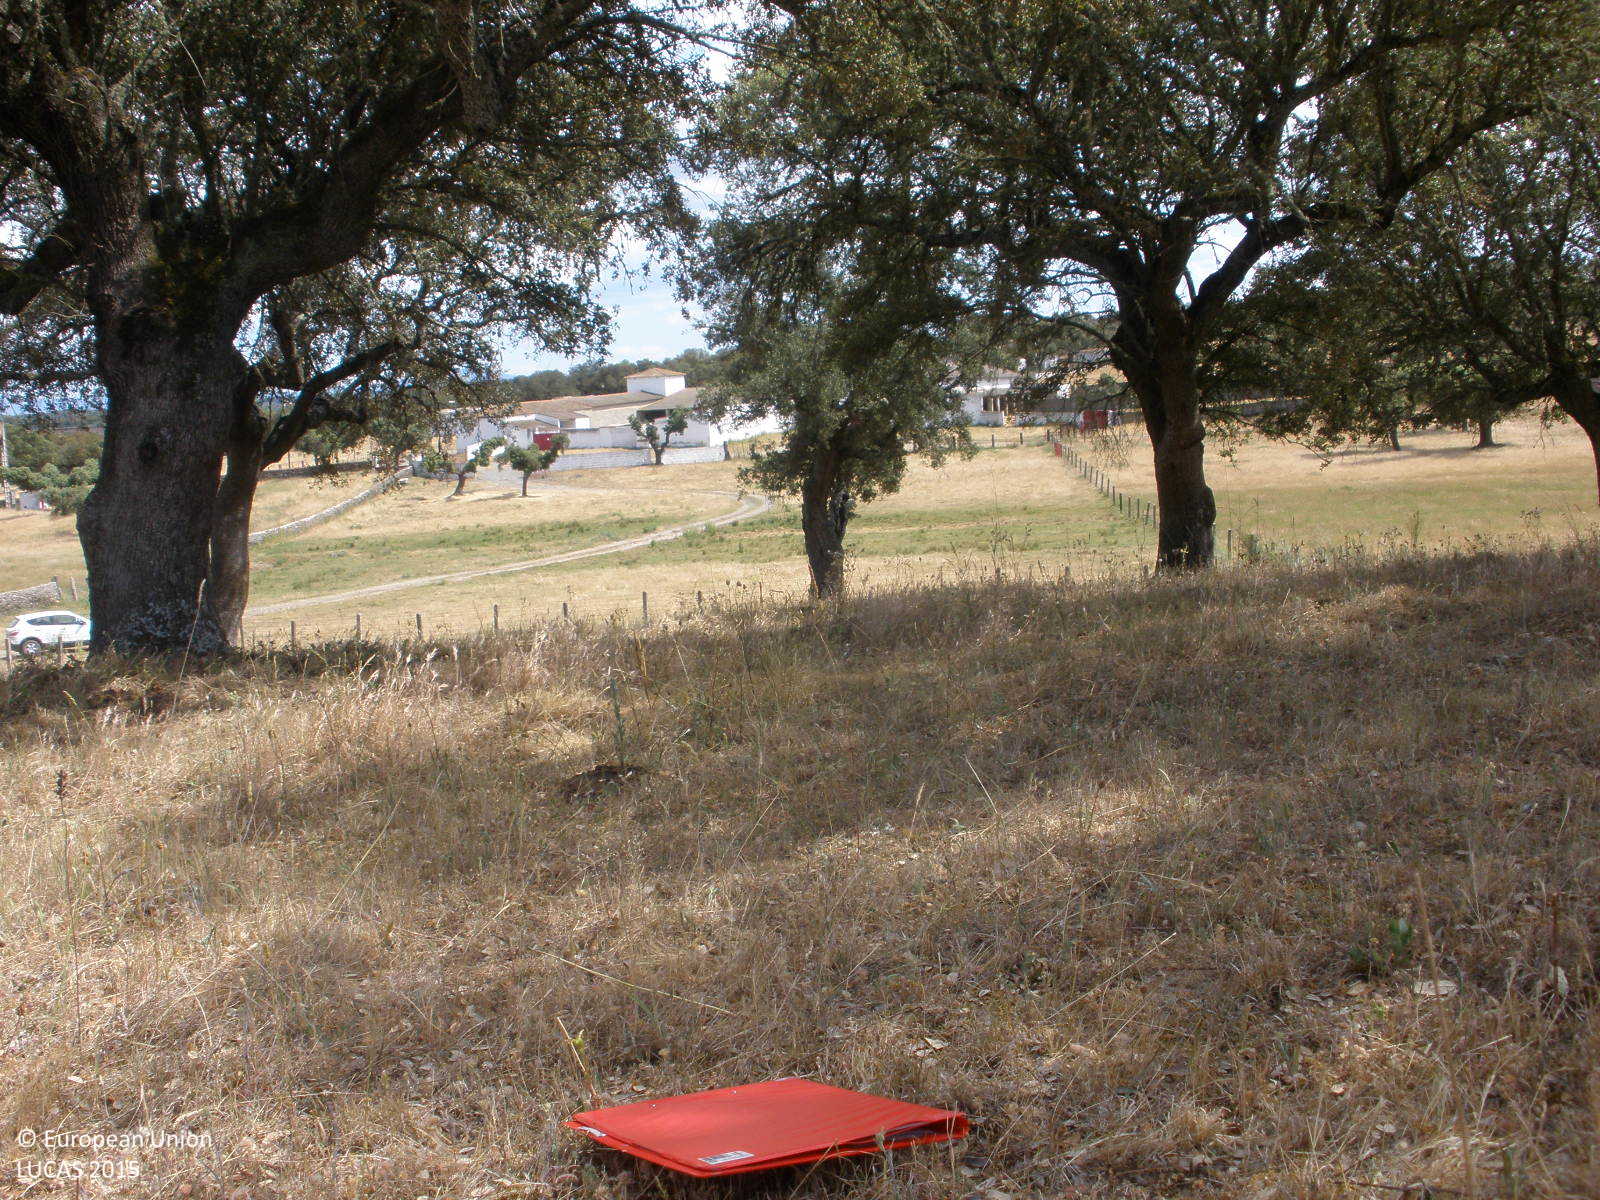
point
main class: Woodland
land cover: Broadleaved woodland
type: broadleaved evergreen forest
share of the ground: 25 - 50 %
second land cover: Grassland without tree/shrub cover
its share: > 75 %
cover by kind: herbaceous plants 60 %, broadleaved forest trees 40 %
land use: Forestry
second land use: Agriculture (excluding fallow land and kitchen gardens)
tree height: > 5 m
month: June
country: ES
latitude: 40.5804
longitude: -6.6674
